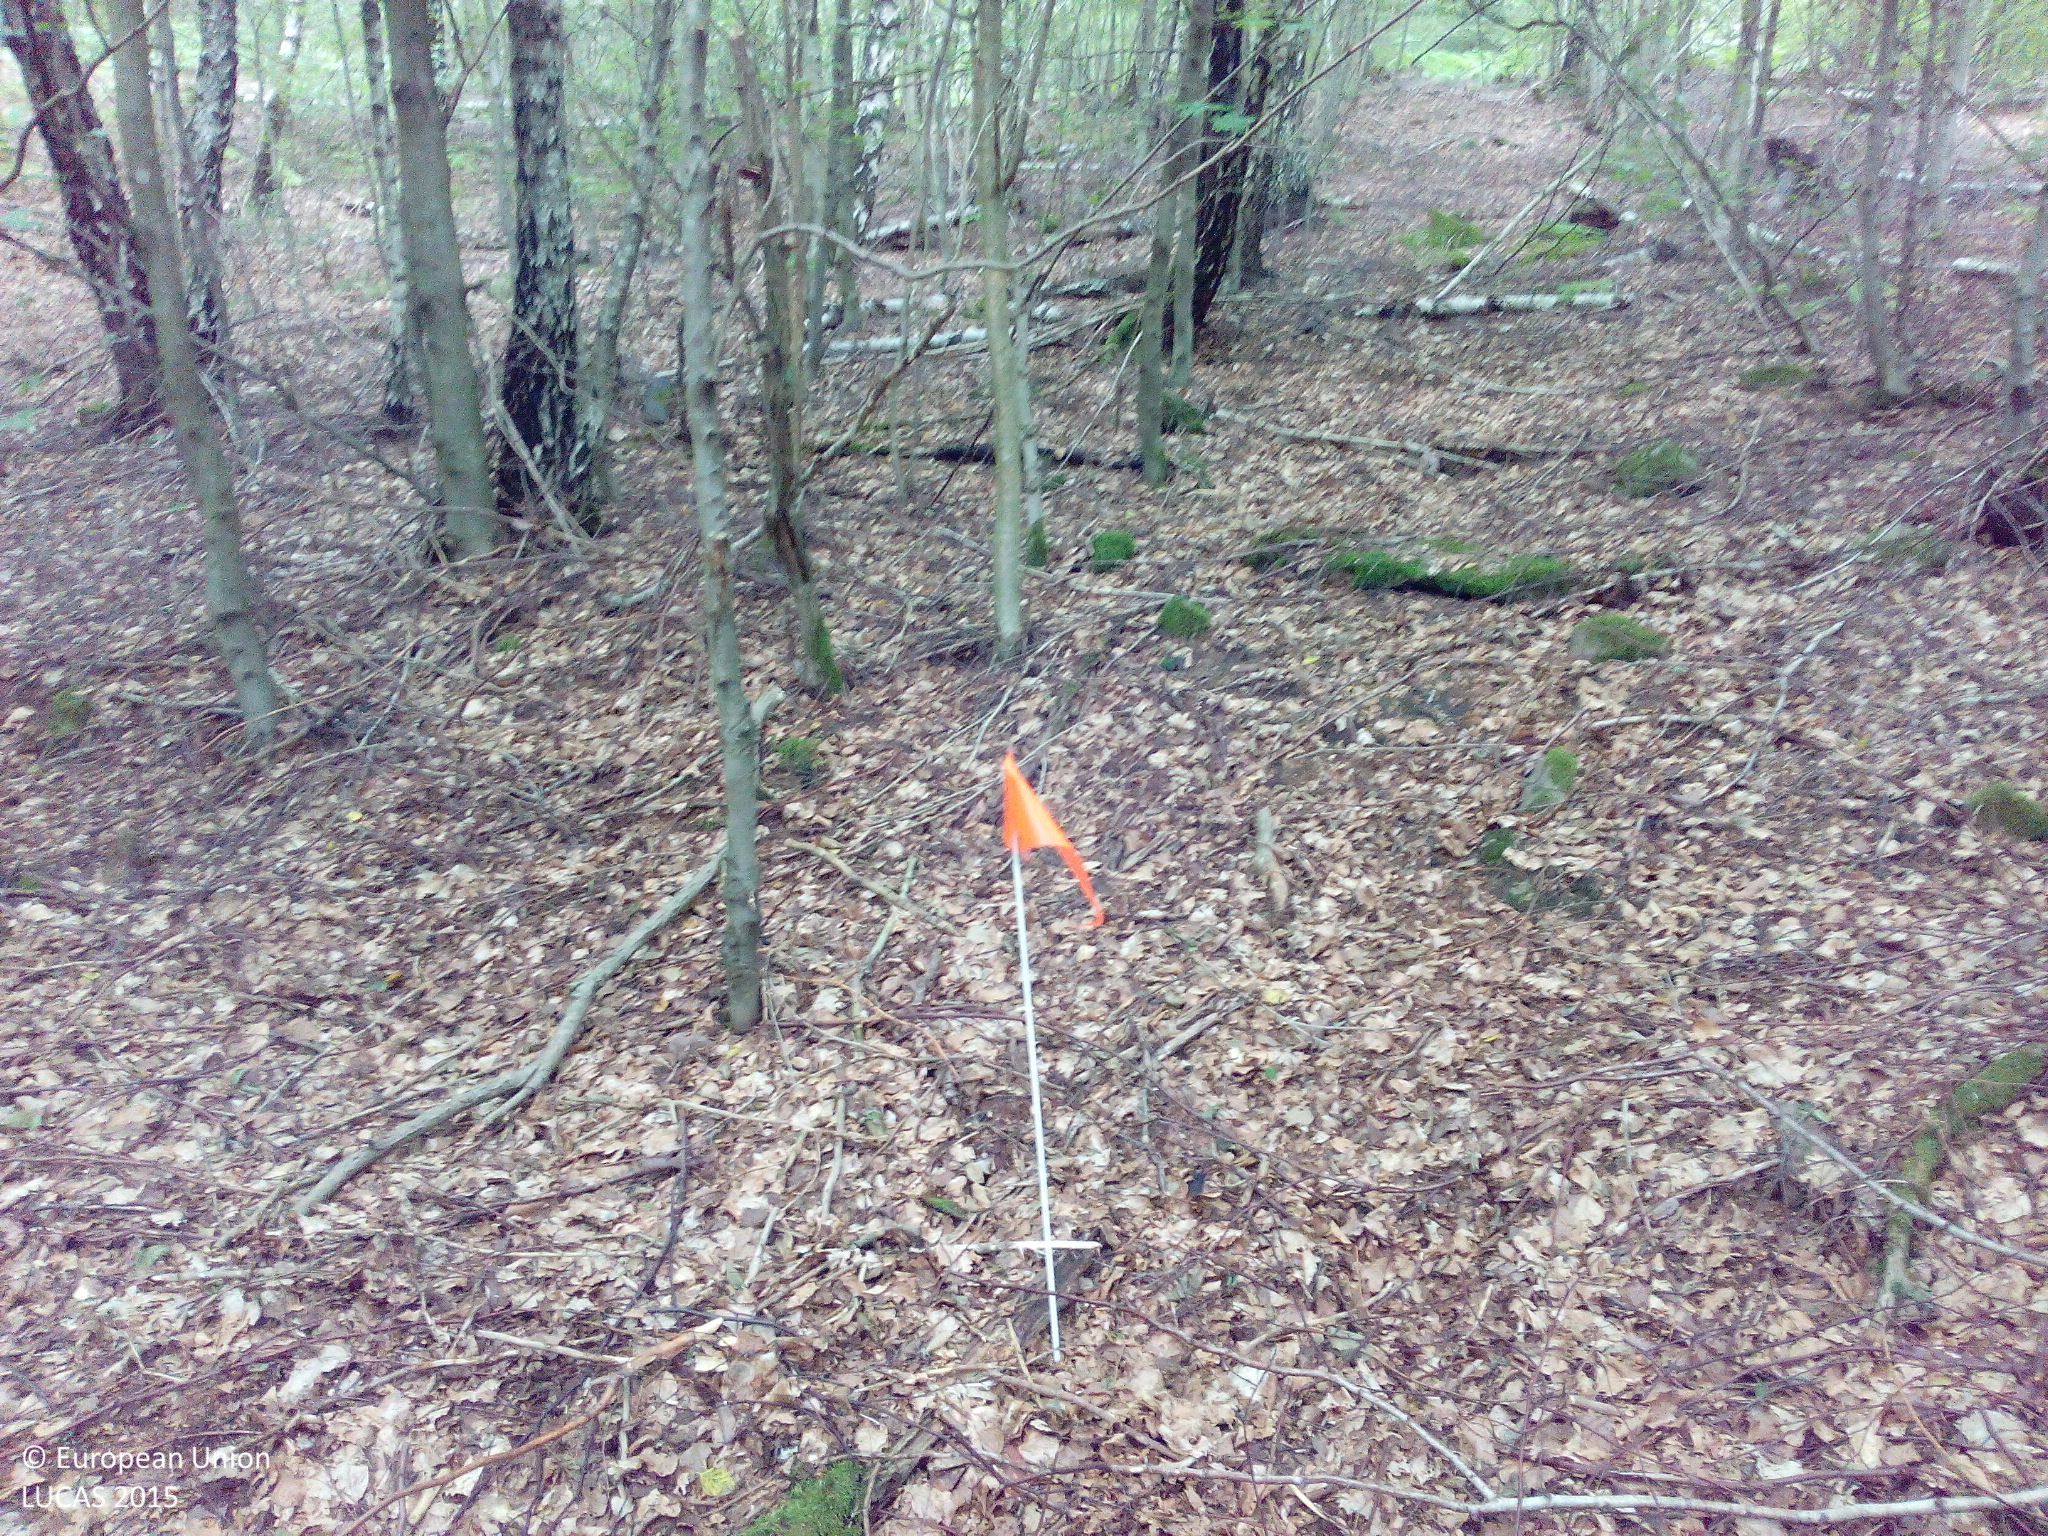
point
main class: Woodland
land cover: Broadleaved woodland
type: beech forest
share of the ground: > 75 %
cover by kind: broadleaved forest trees 100 %
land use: Forestry
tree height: > 5 m
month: July
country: DE
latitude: 50.5798
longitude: 9.9012
